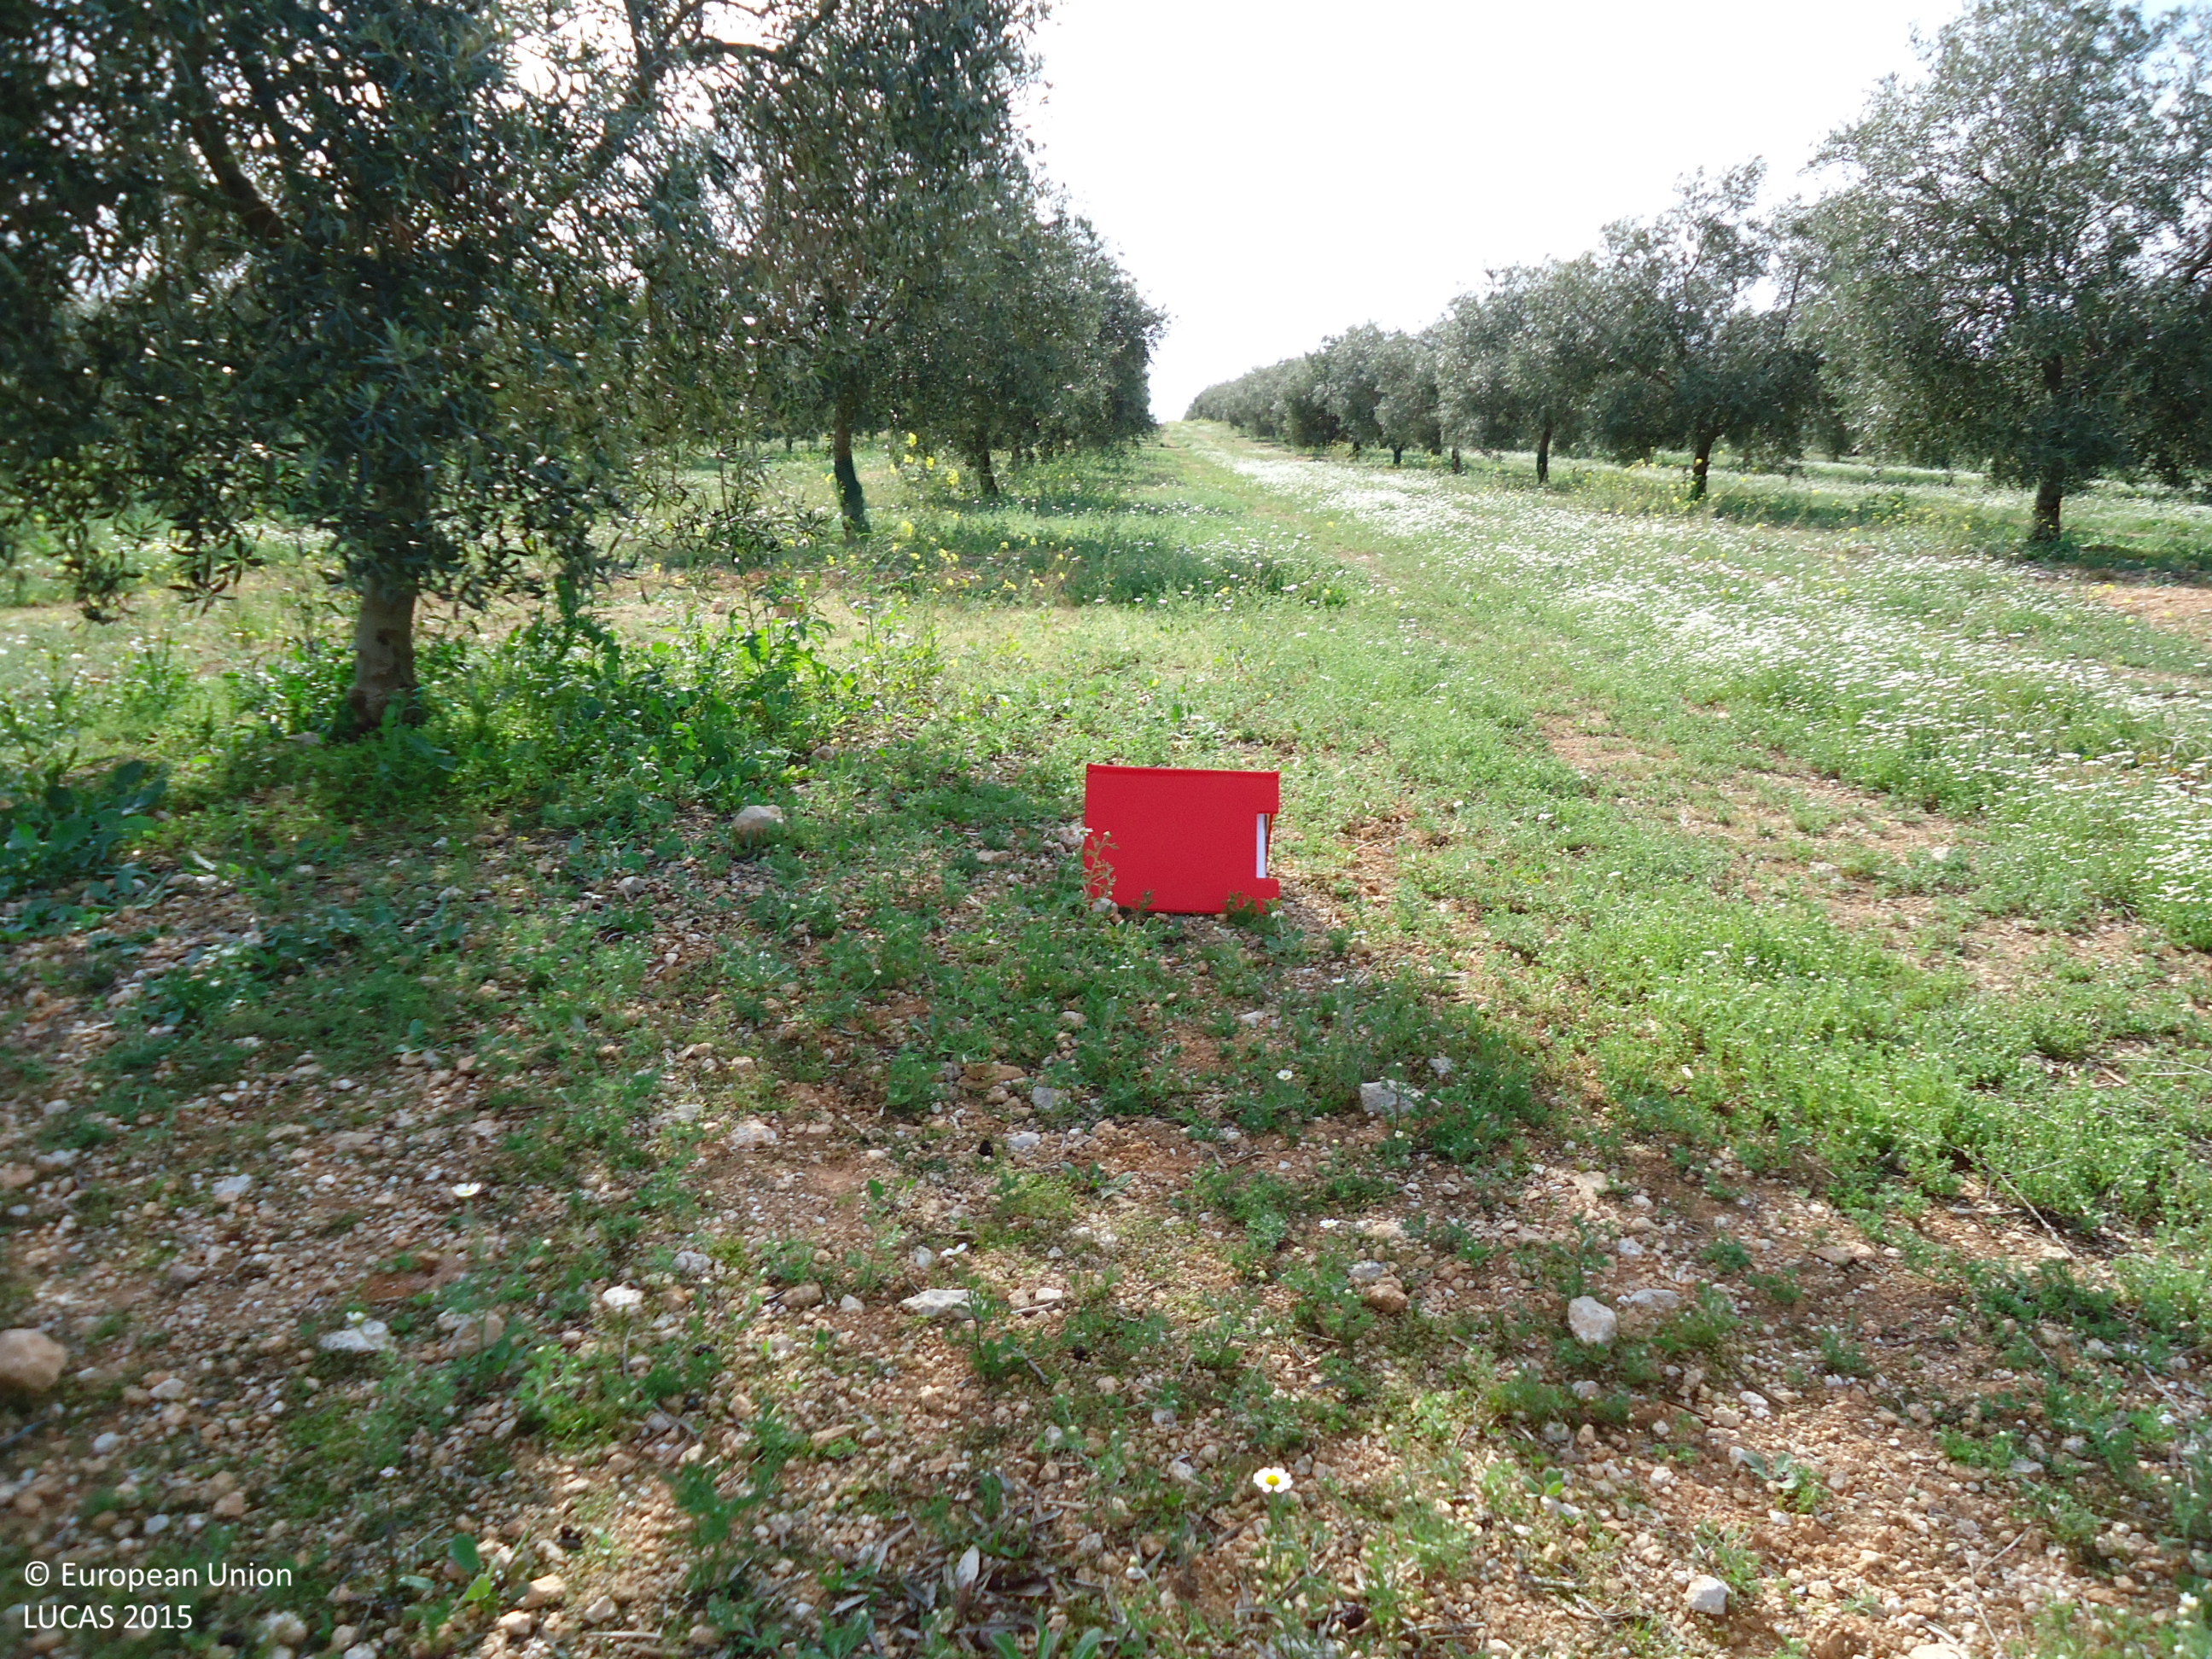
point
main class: Cropland
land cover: Olive groves
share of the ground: 25 - 50 %
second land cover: Spontaneously vegetated surfaces
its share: > 75 %
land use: Agriculture (excluding fallow land and kitchen gardens)
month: April
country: ES
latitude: 37.1303
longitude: -4.8264
